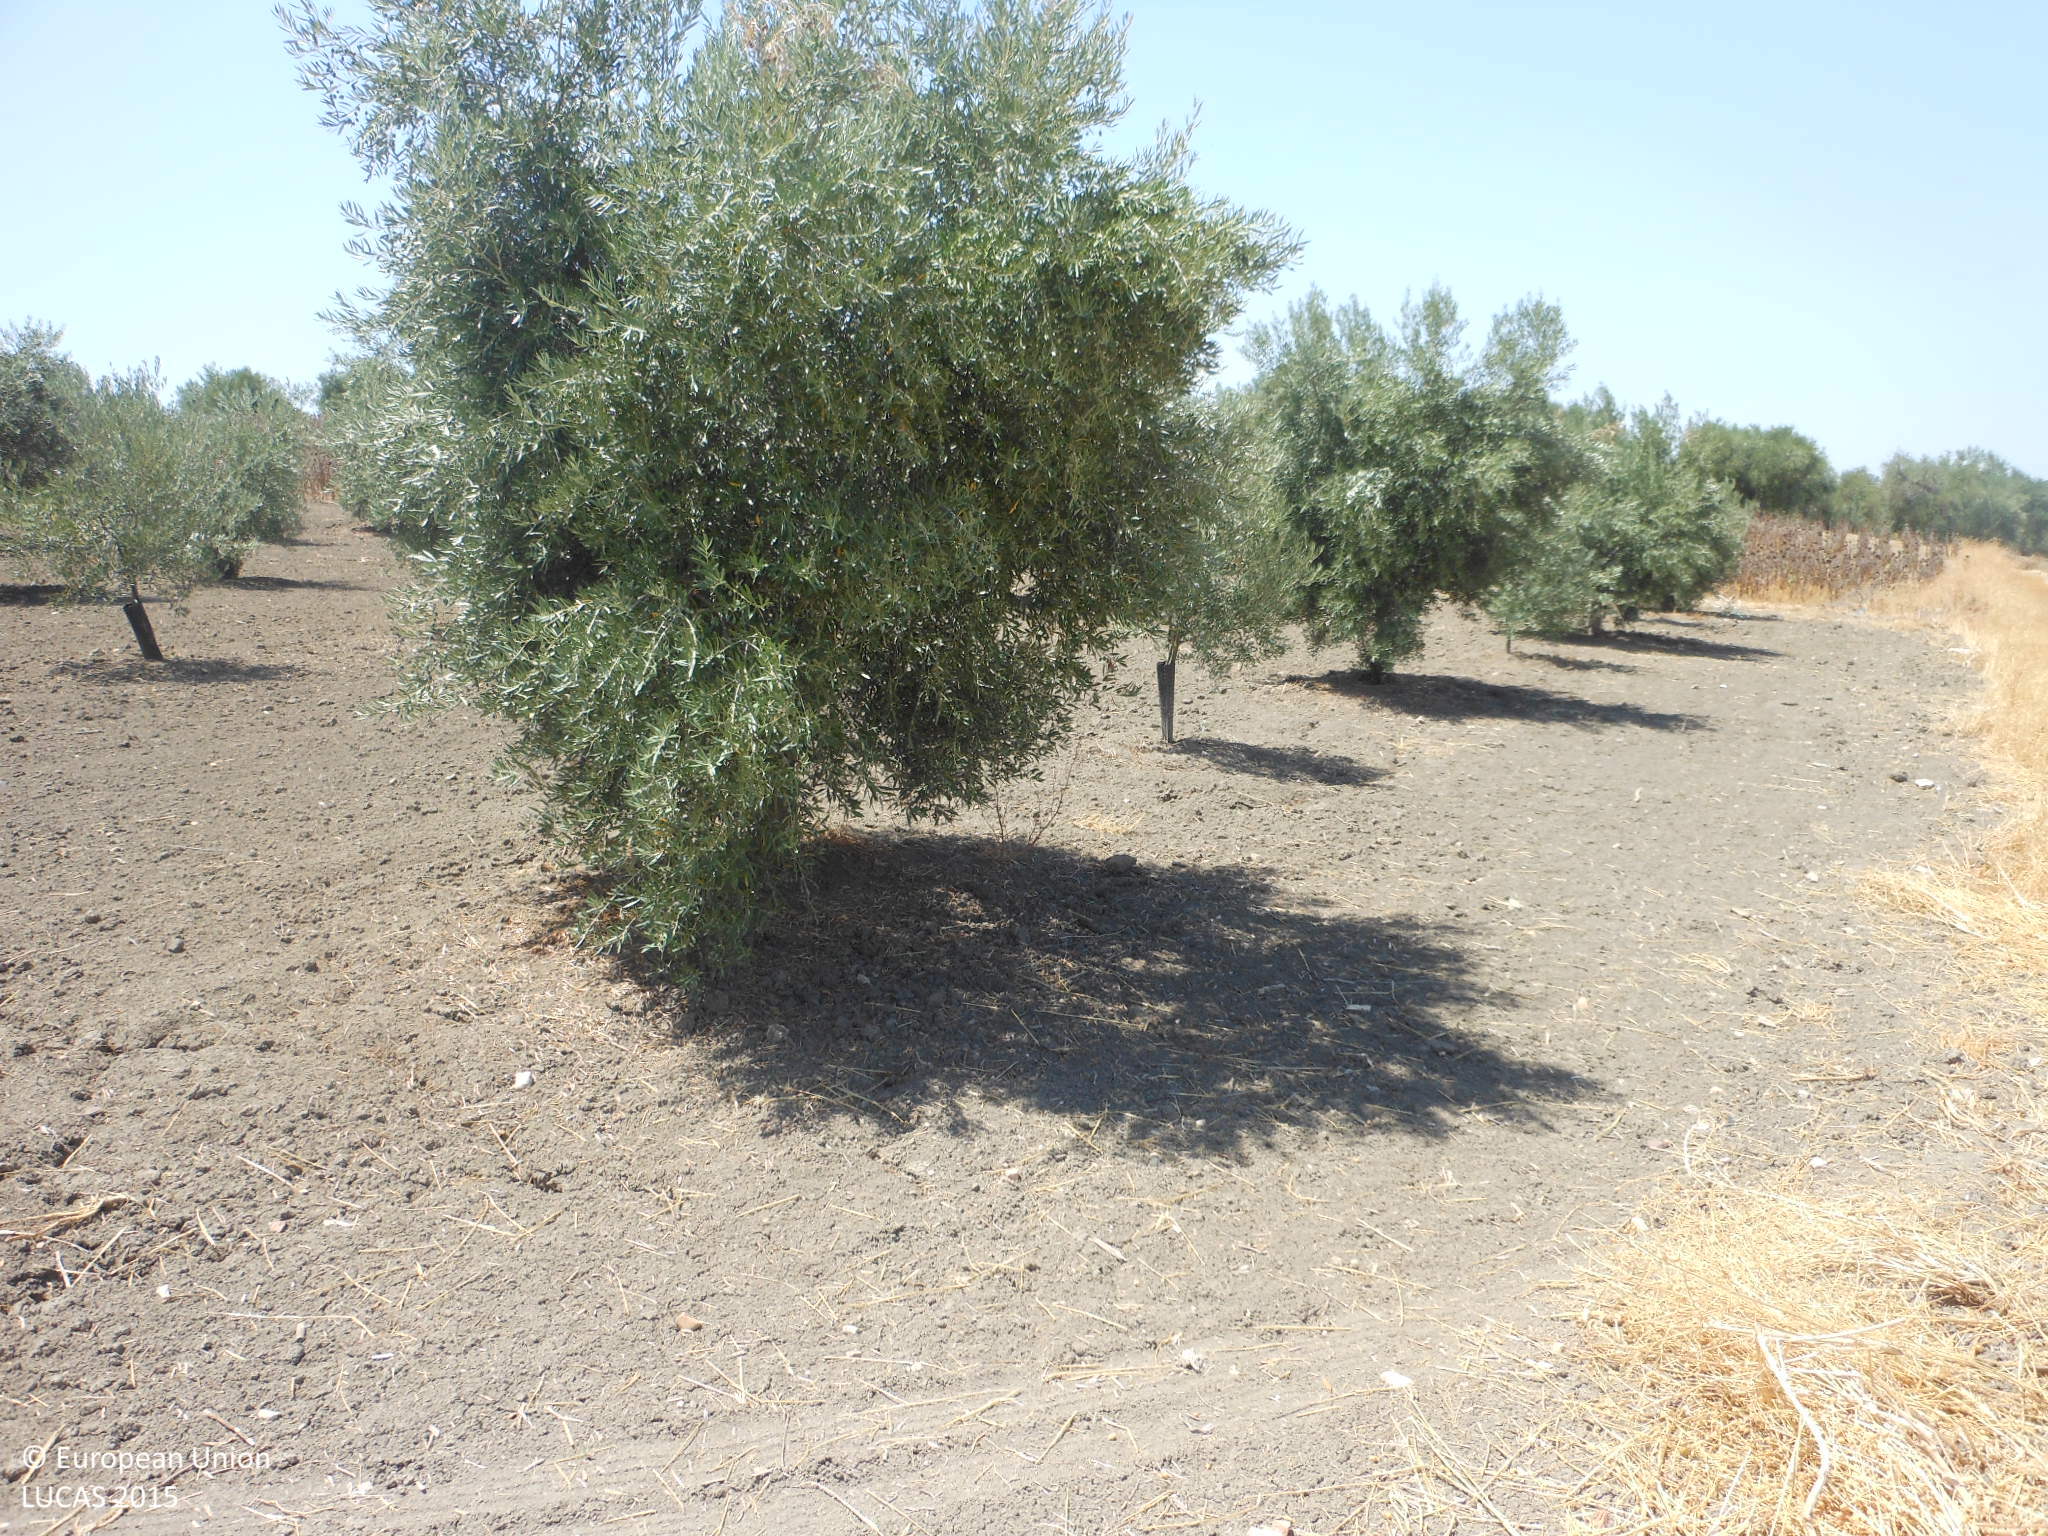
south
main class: Cropland
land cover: Common wheat
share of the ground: < 10 %
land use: Agriculture (excluding fallow land and kitchen gardens)
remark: Harvested field
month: July
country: ES
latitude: 37.2476
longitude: -5.3547
